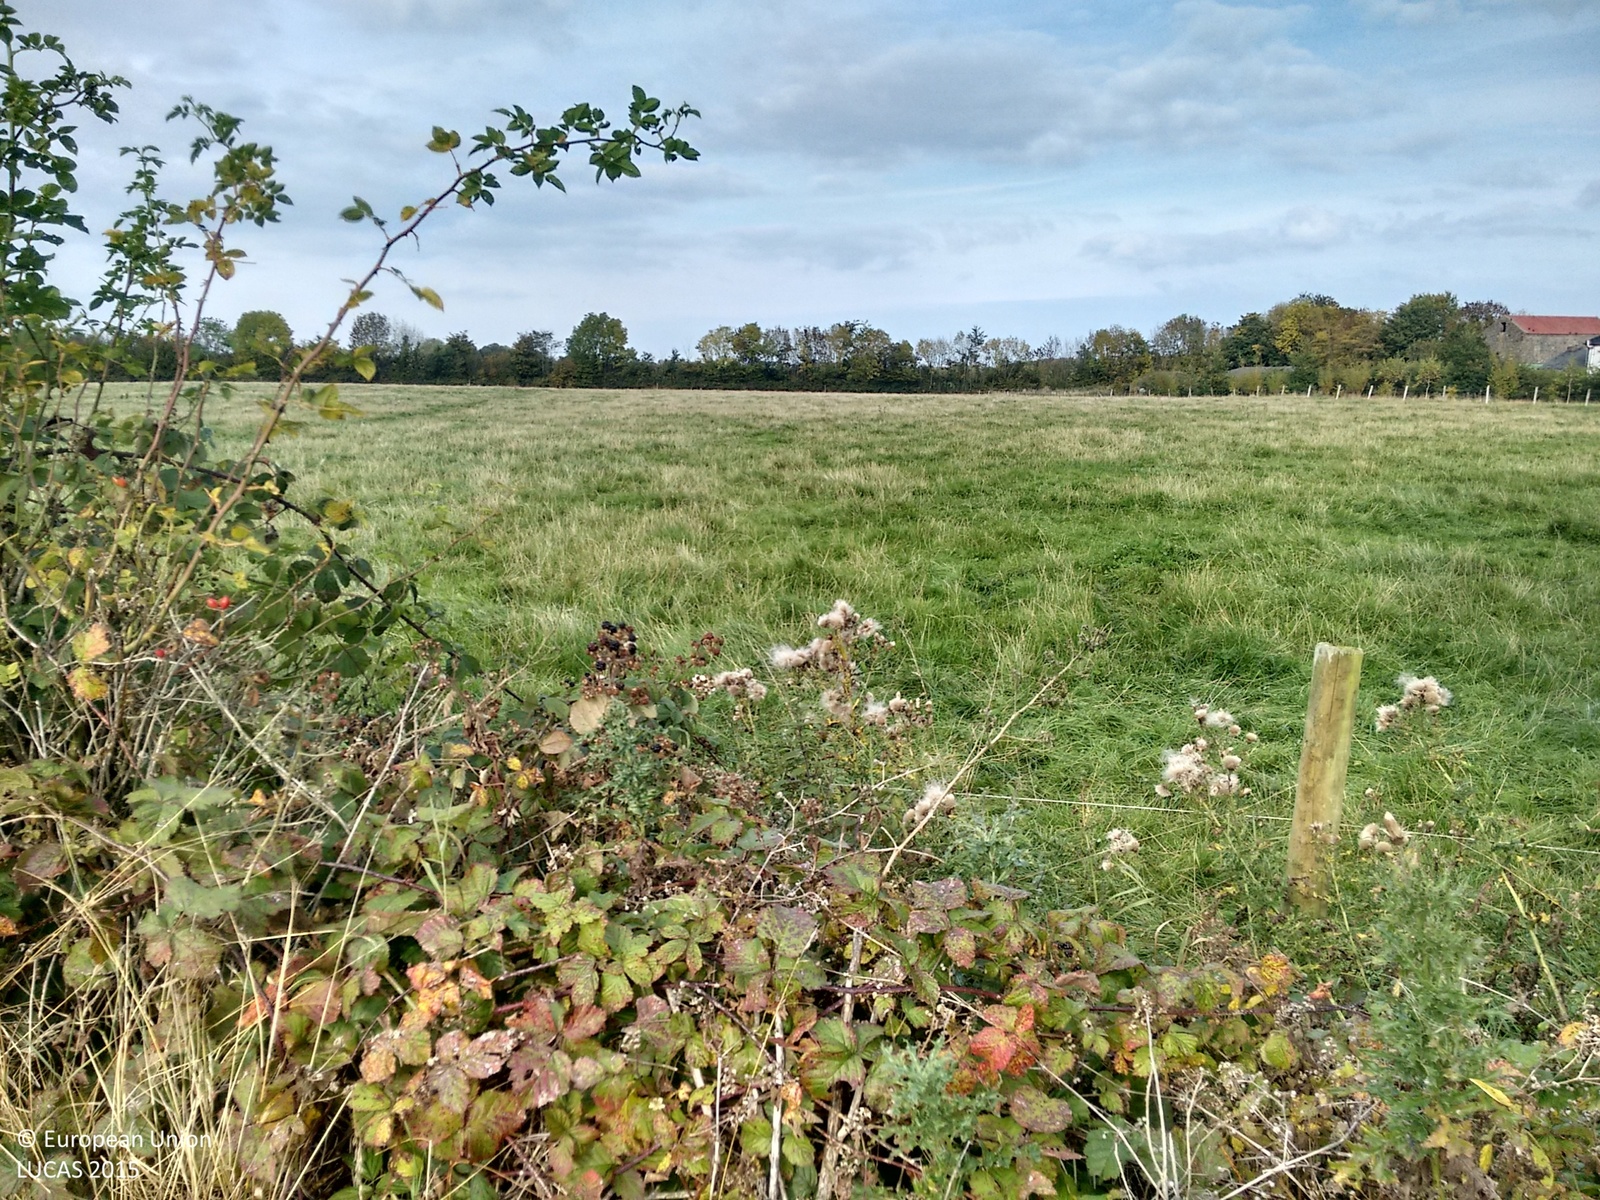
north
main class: Grassland
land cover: Grassland without tree/shrub cover
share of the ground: > 75 %
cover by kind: herbaceous plants 100 %
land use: Agriculture (excluding fallow land and kitchen gardens)
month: October
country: IE
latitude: 52.9511
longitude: -7.9296
